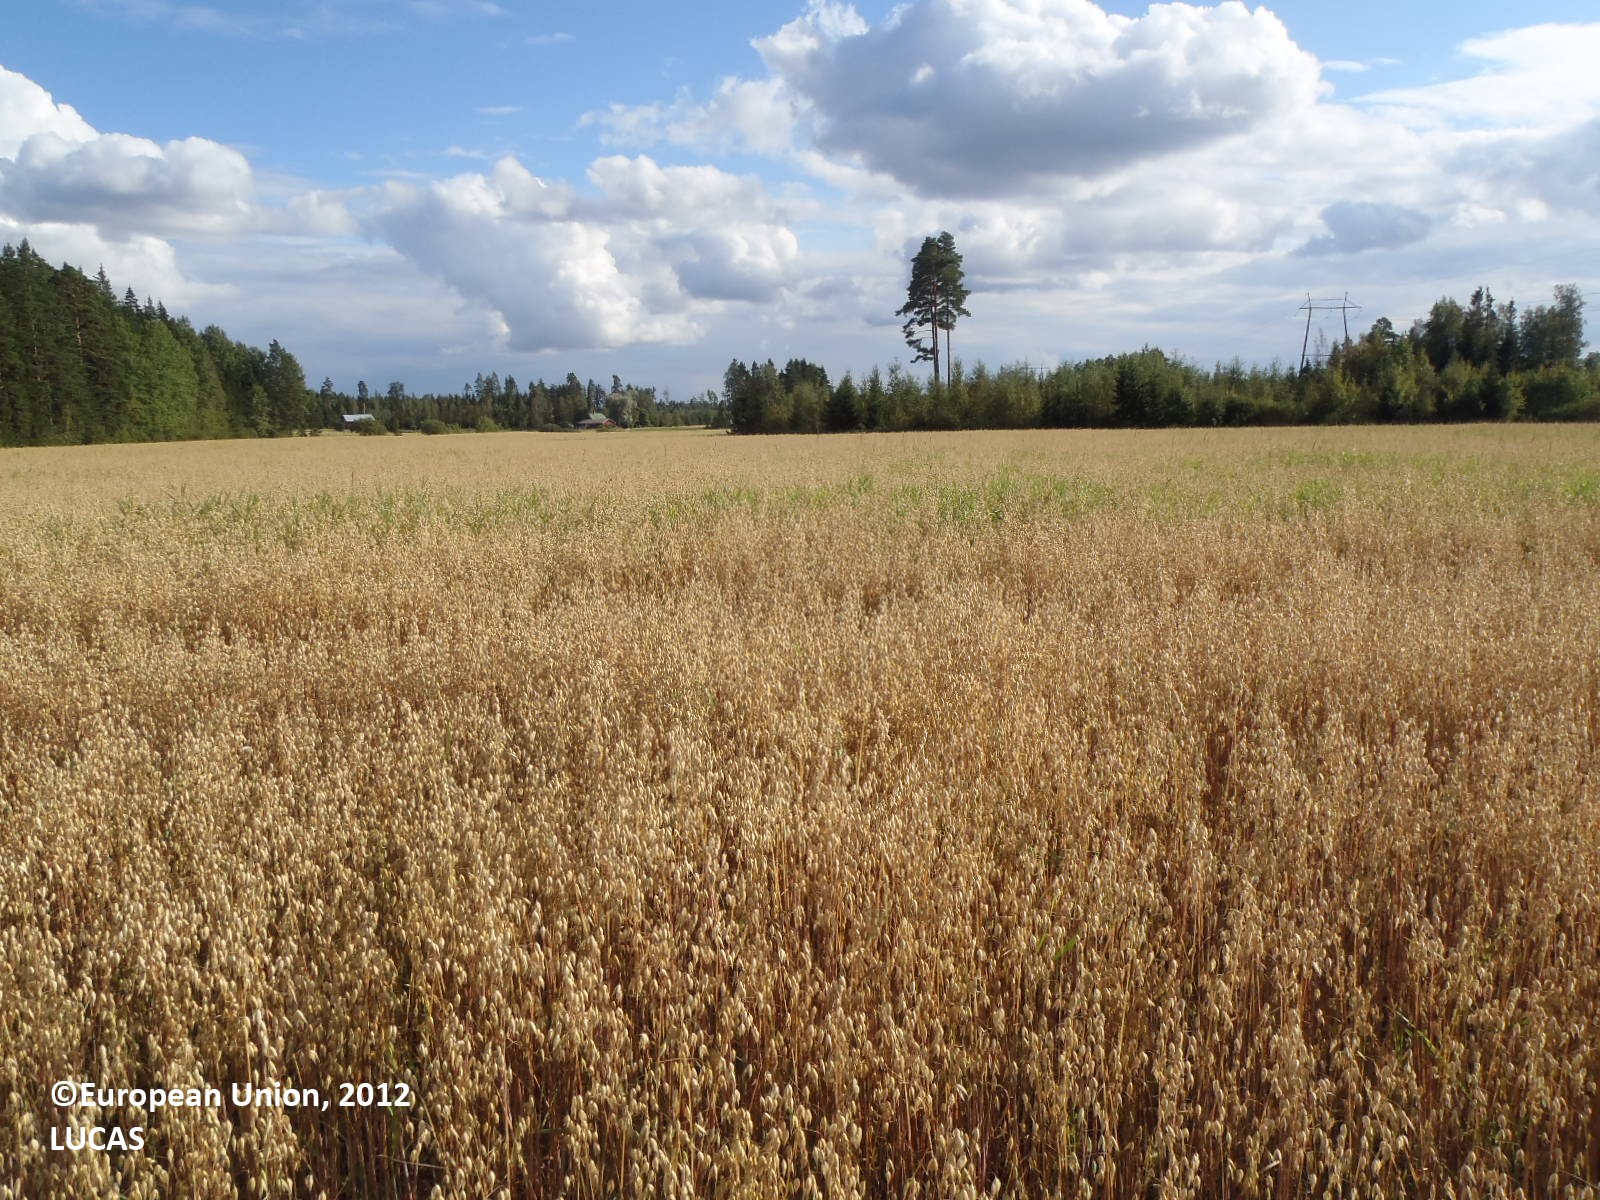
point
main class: Cropland
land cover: Oats
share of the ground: > 75 %
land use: Agriculture (excluding fallow land and kitchen gardens)
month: August
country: FI
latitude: 60.6556
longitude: 22.7874
